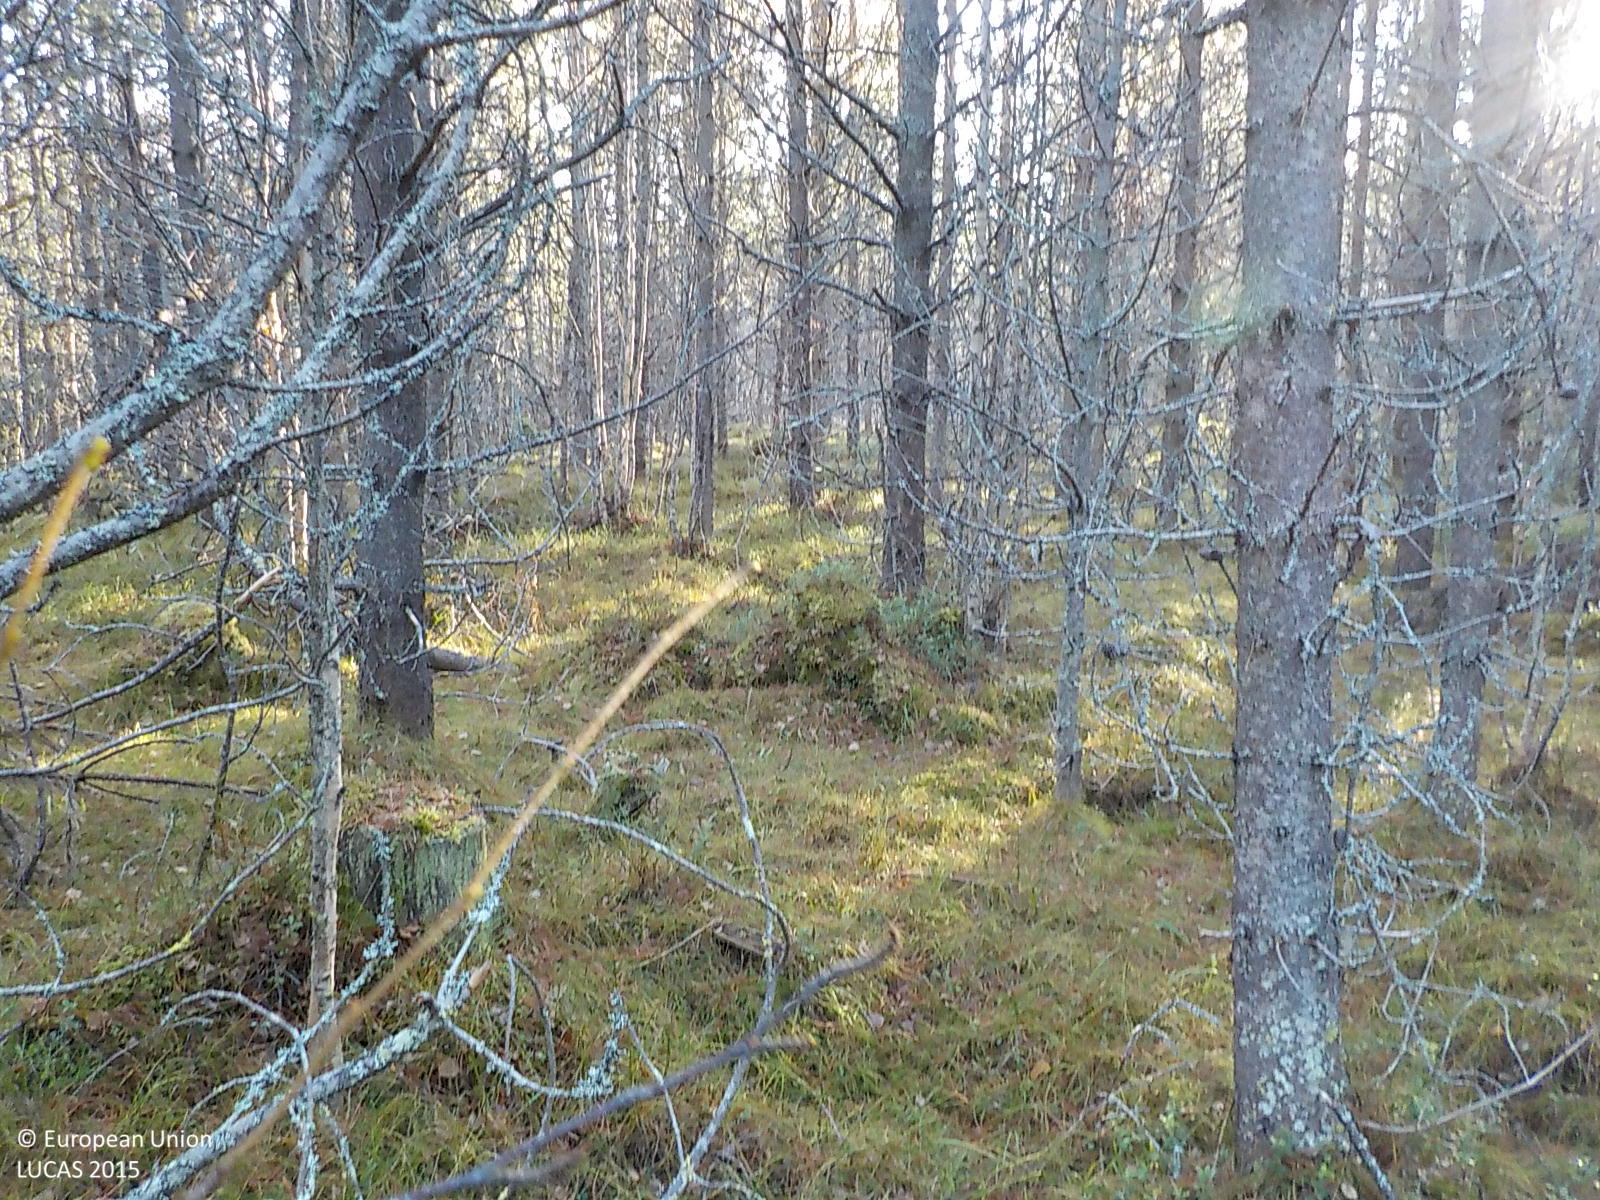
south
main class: Woodland
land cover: Pine dominated coniferous woodland
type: exotic forest
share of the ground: > 75 %
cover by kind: coniferous forest trees 80 %, shrubs 20 %
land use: Forestry
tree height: > 5 m
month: November
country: SE
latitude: 63.2330
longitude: 16.4834
